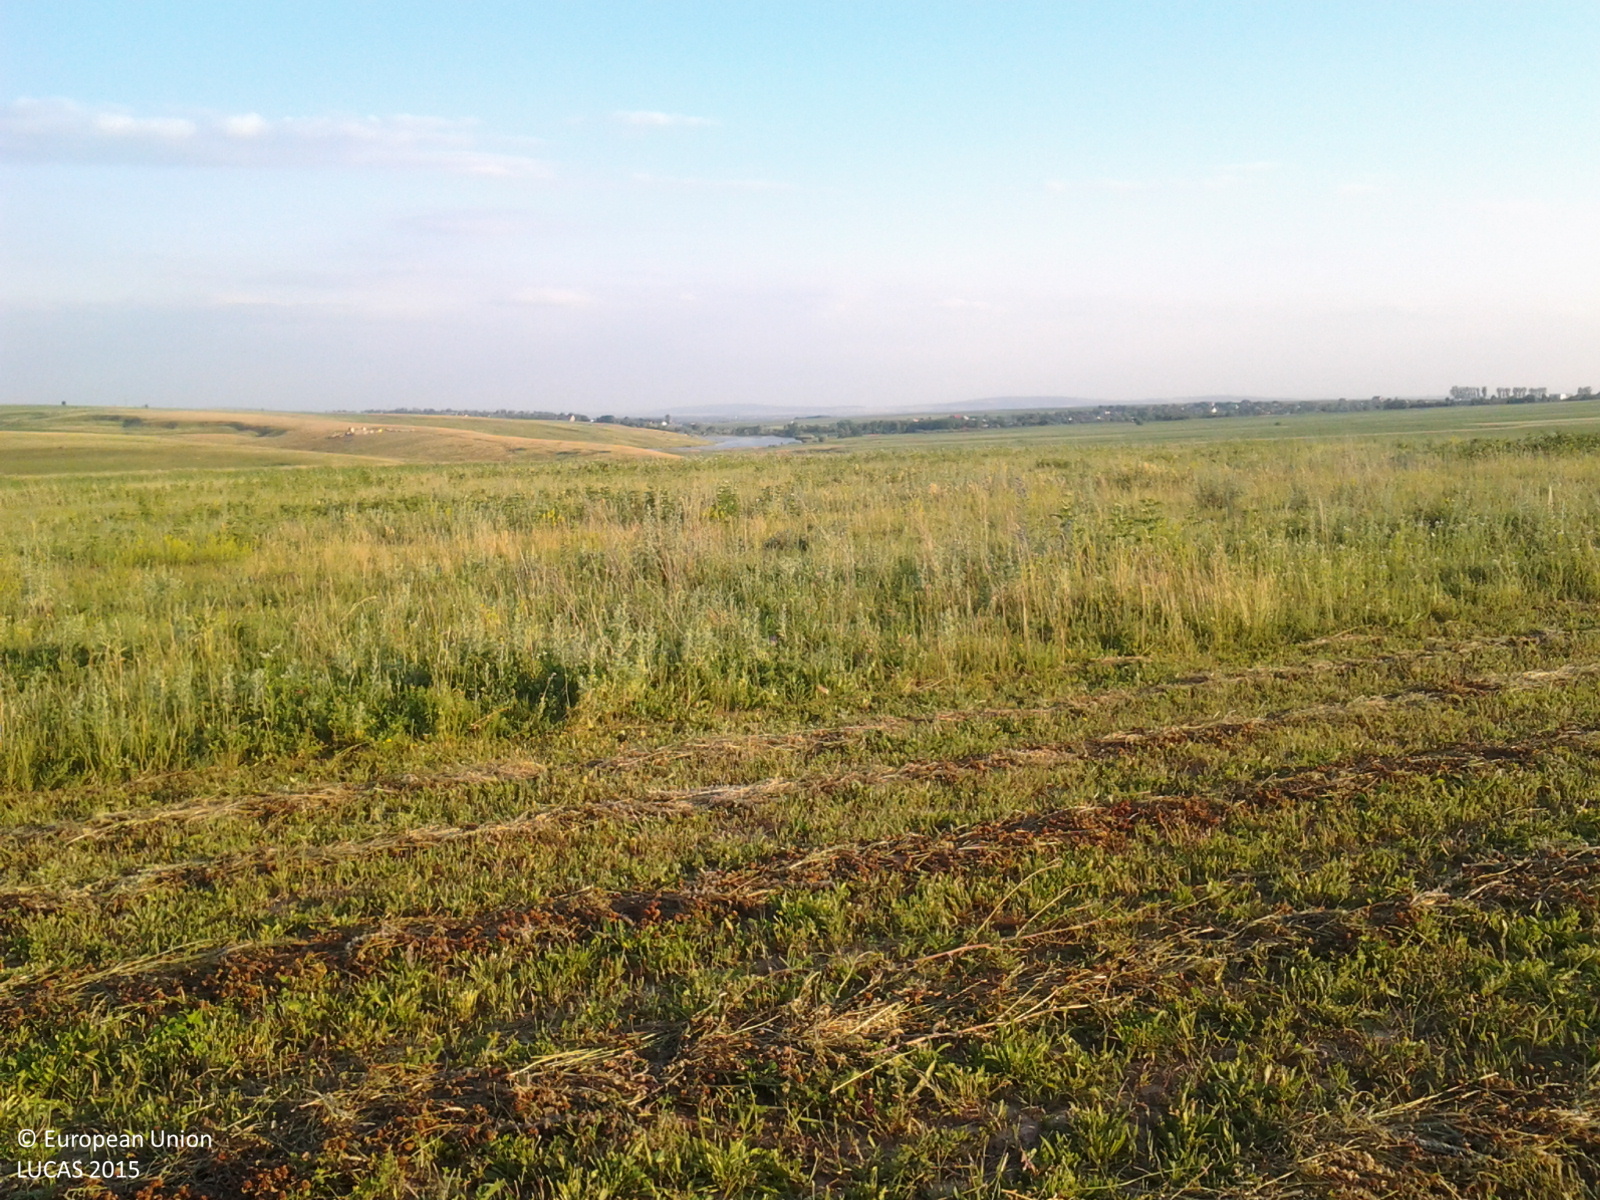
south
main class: Grassland
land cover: Grassland without tree/shrub cover
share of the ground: > 75 %
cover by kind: herbaceous plants 100 %
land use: Agriculture (excluding fallow land and kitchen gardens)
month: June
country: RO
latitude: 47.7350
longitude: 26.5330
